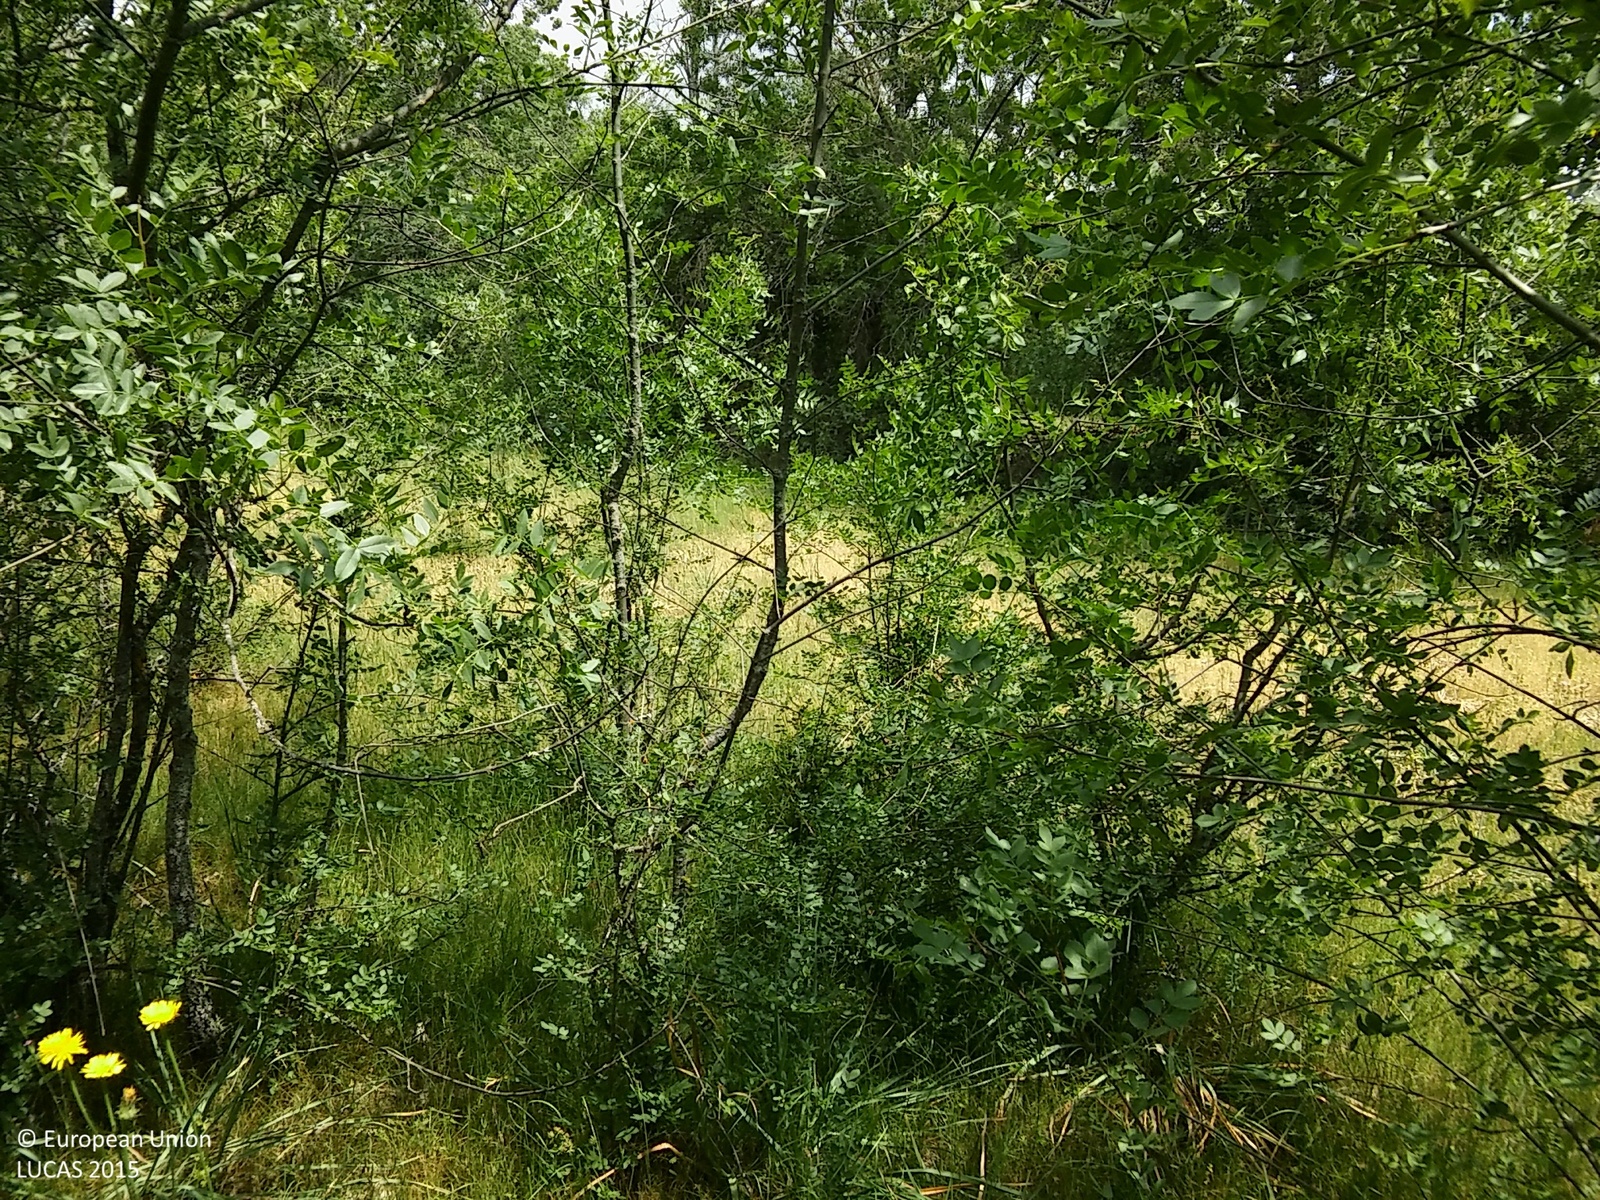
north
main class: Woodland
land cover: Broadleaved woodland
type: non-riverine alder, birch or aspen forest
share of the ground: 25 - 50 %
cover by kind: herbaceous plants 60 %, broadleaved forest trees 25 %, shrubs 15 %
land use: Abandoned areas
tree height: > 5 m
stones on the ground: < 10 %
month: June
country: ES
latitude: 41.1490
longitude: -3.7138
